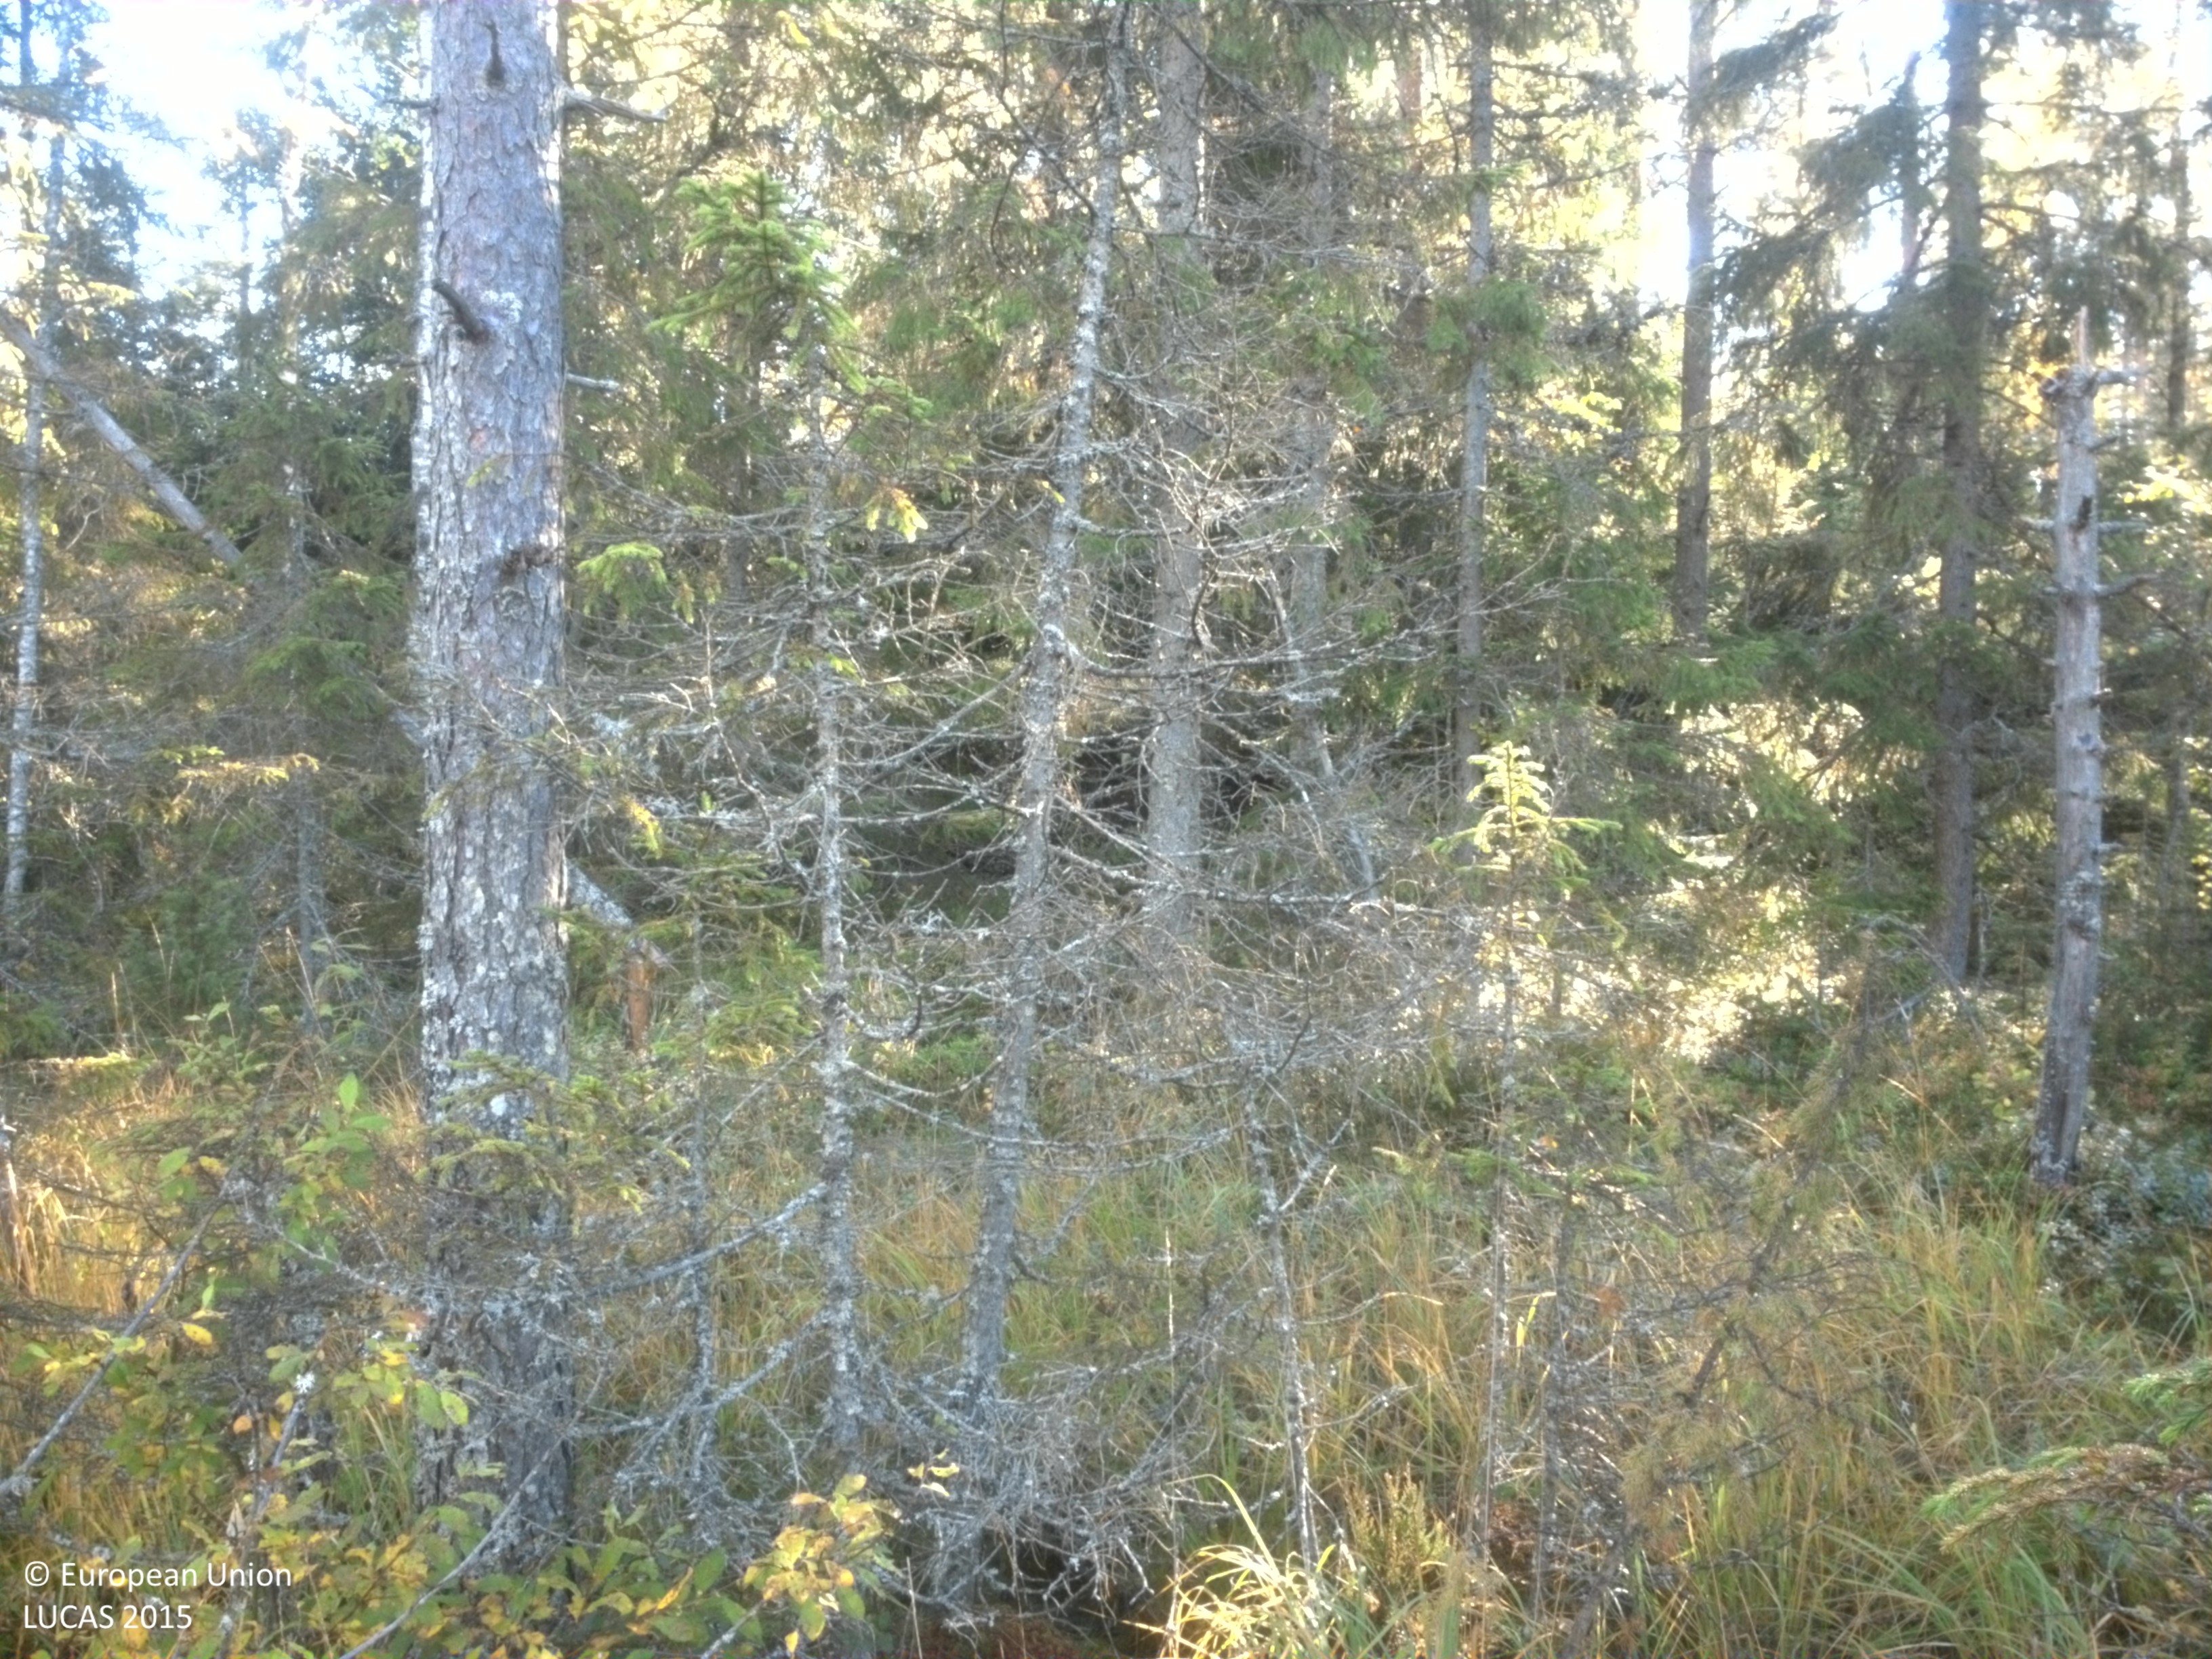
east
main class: Woodland
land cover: Other mixed woodland
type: mire and swamp forests
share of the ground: 50 - 75 %
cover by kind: coniferous forest trees 45 %, broadleaved forest trees 15 %, herbaceous plants 15 %, lichens and mosses 15 %, shrubs 10 %
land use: Forestry
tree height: > 5 m
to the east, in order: Other mixed woodland; Shruby margins; Paved roads, cycling and walking lanes; Spruce dominated mixed woodland; Pine dominated coniferous woodland; Spruce dominated coniferous woodland; Rivers and streams; Spruce dominated coniferous woodland; Ditches and canals; Spruce dominated coniferous woodland
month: September
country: SE
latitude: 59.9047
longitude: 15.1924
